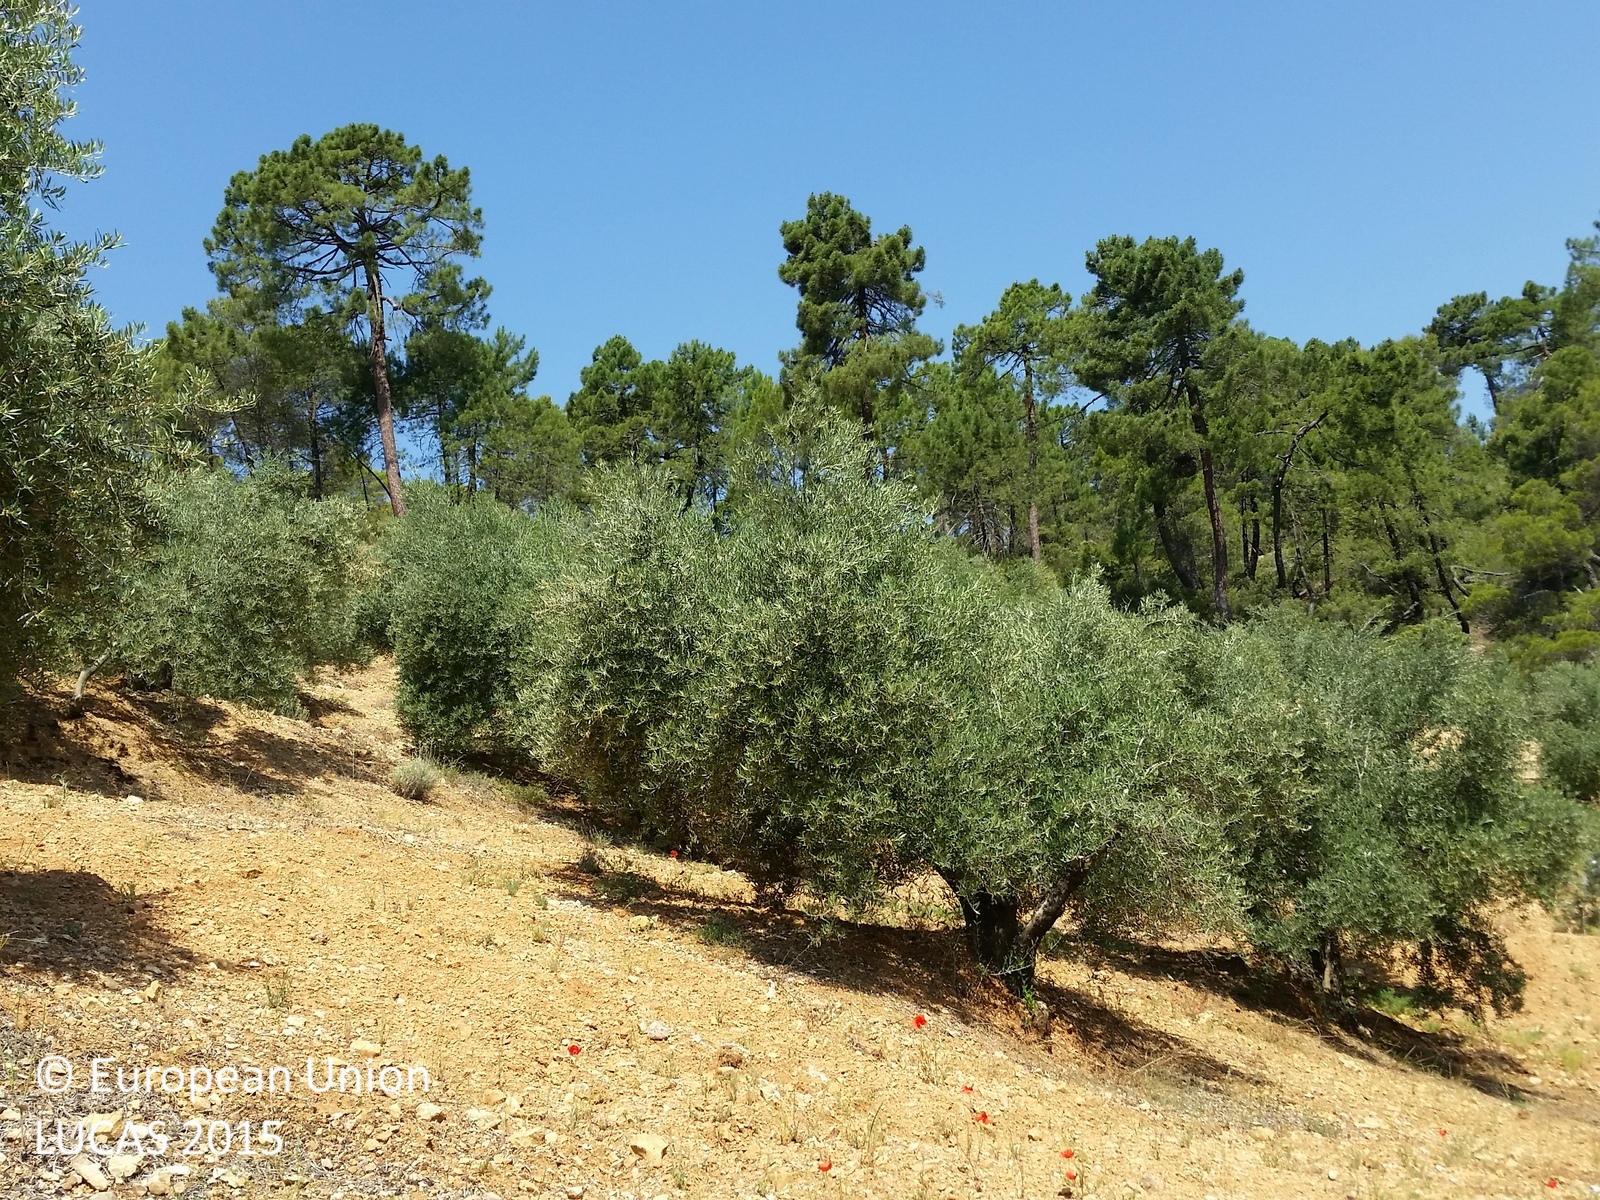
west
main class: Cropland
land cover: Olive groves
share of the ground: 50 - 75 %
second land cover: Spontaneously vegetated surfaces
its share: 10 - 25 %
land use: Agriculture (excluding fallow land and kitchen gardens)
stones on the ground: 10 - 25 %
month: June
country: ES
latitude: 38.4312
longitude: -2.5653
